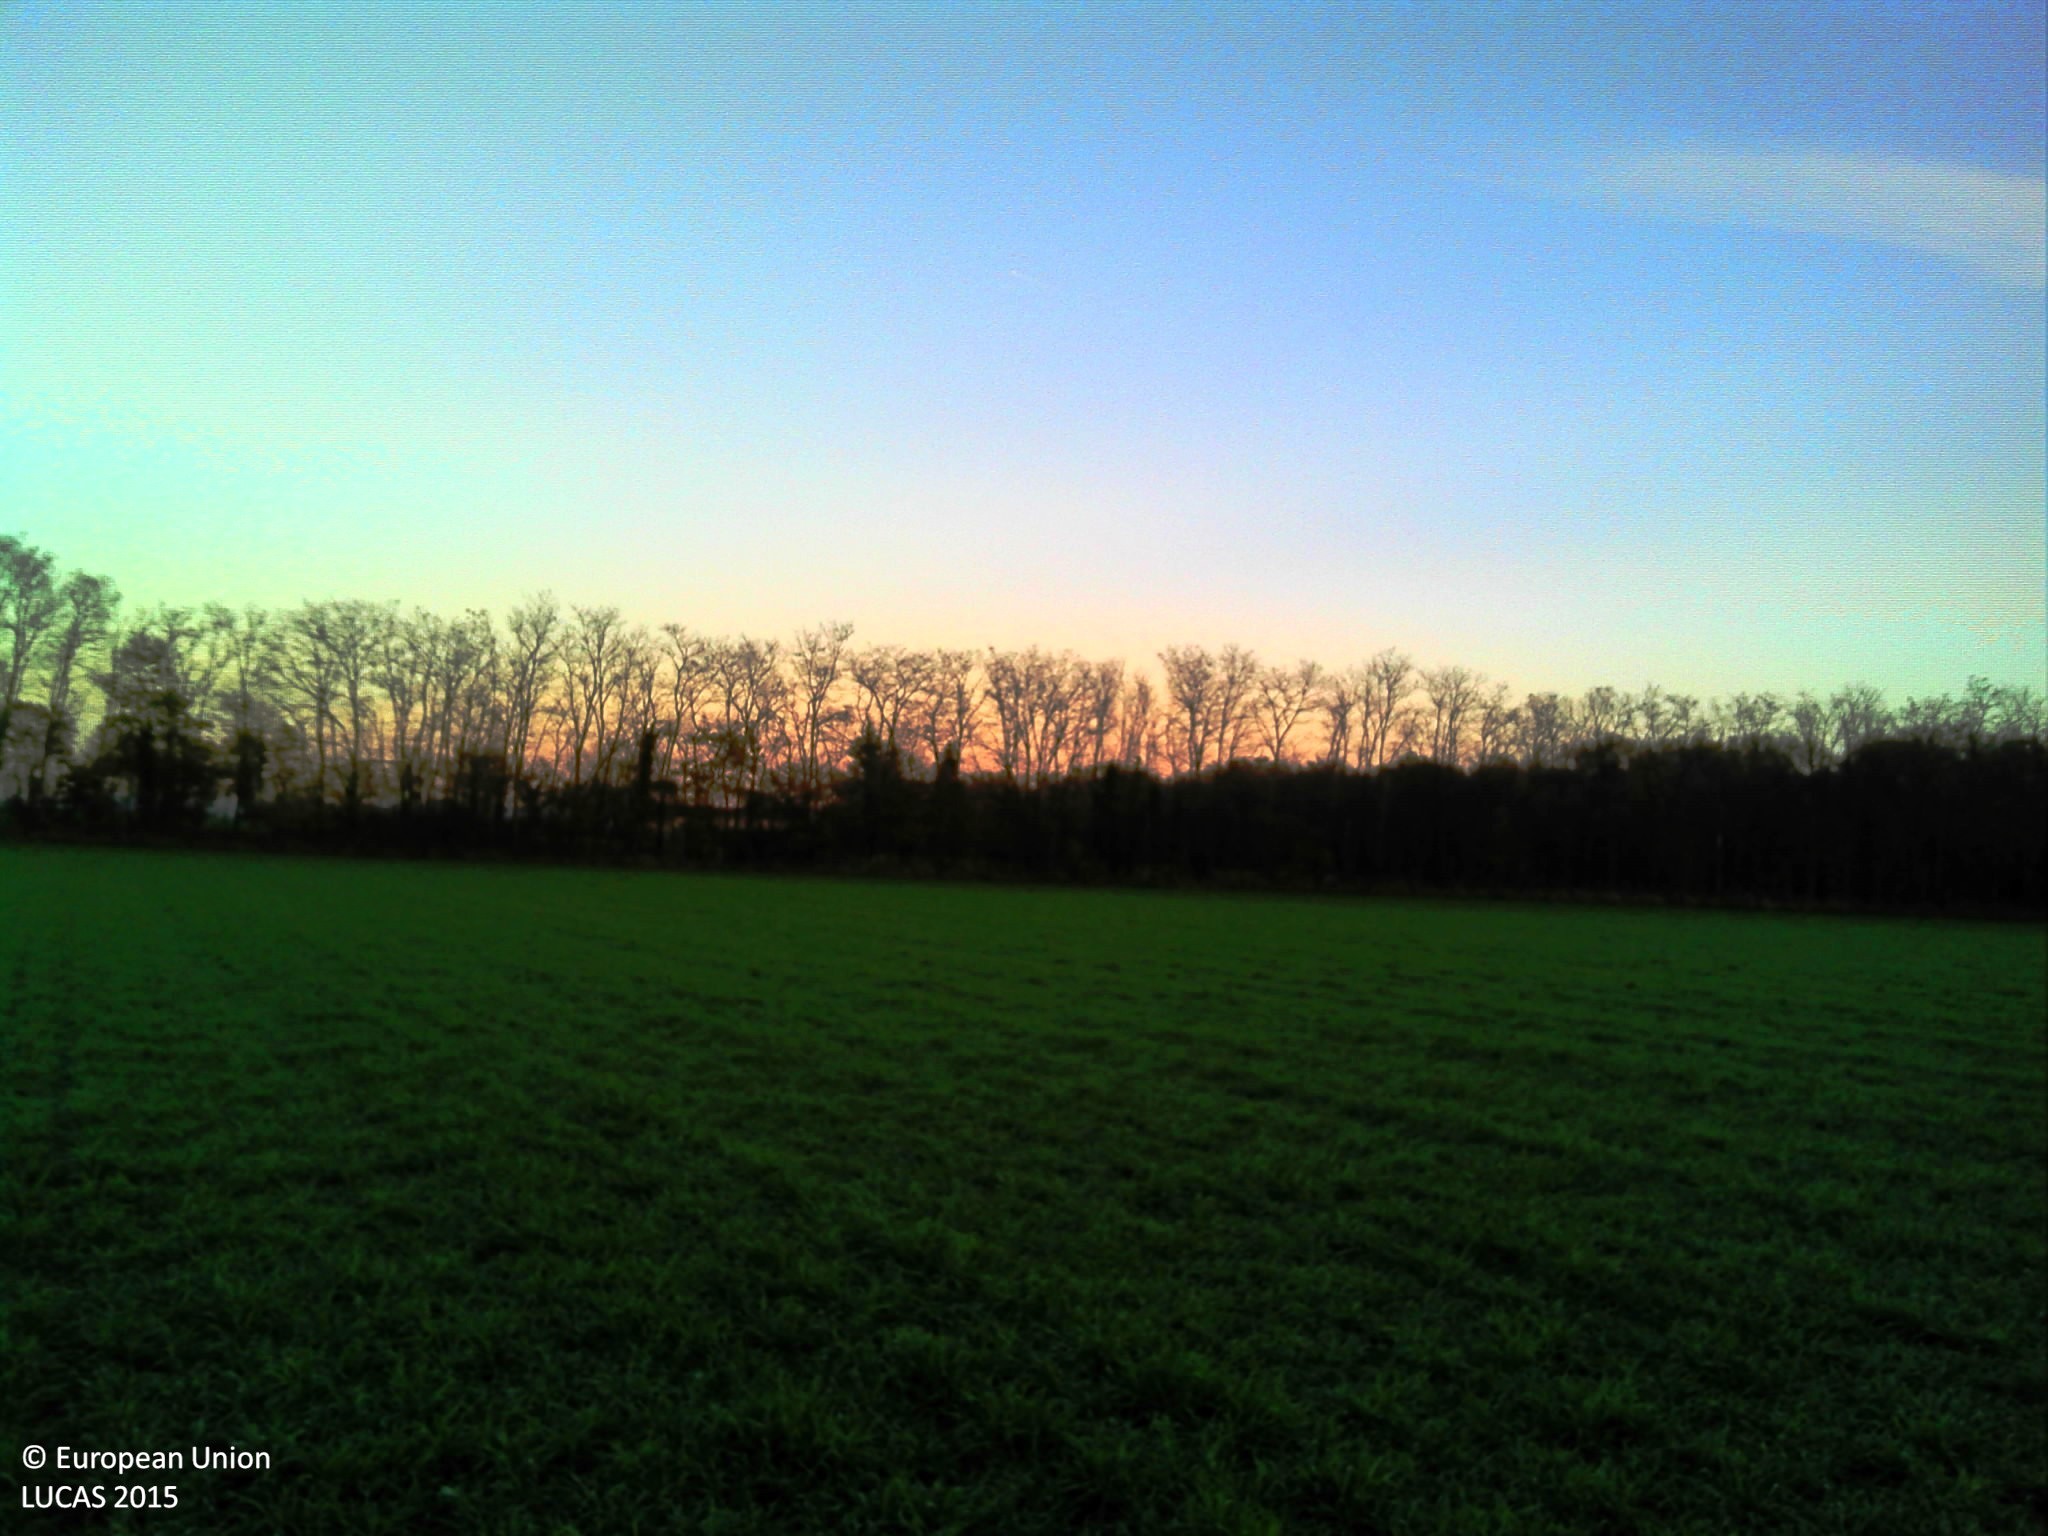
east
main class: Cropland
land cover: Temporary grasslands
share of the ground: > 75 %
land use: Agriculture (excluding fallow land and kitchen gardens)
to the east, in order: Temporary grasslands; Broadleaved woodland; Grassland without tree/shrub cover
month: December
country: FR
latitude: 46.0407
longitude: 5.1058
